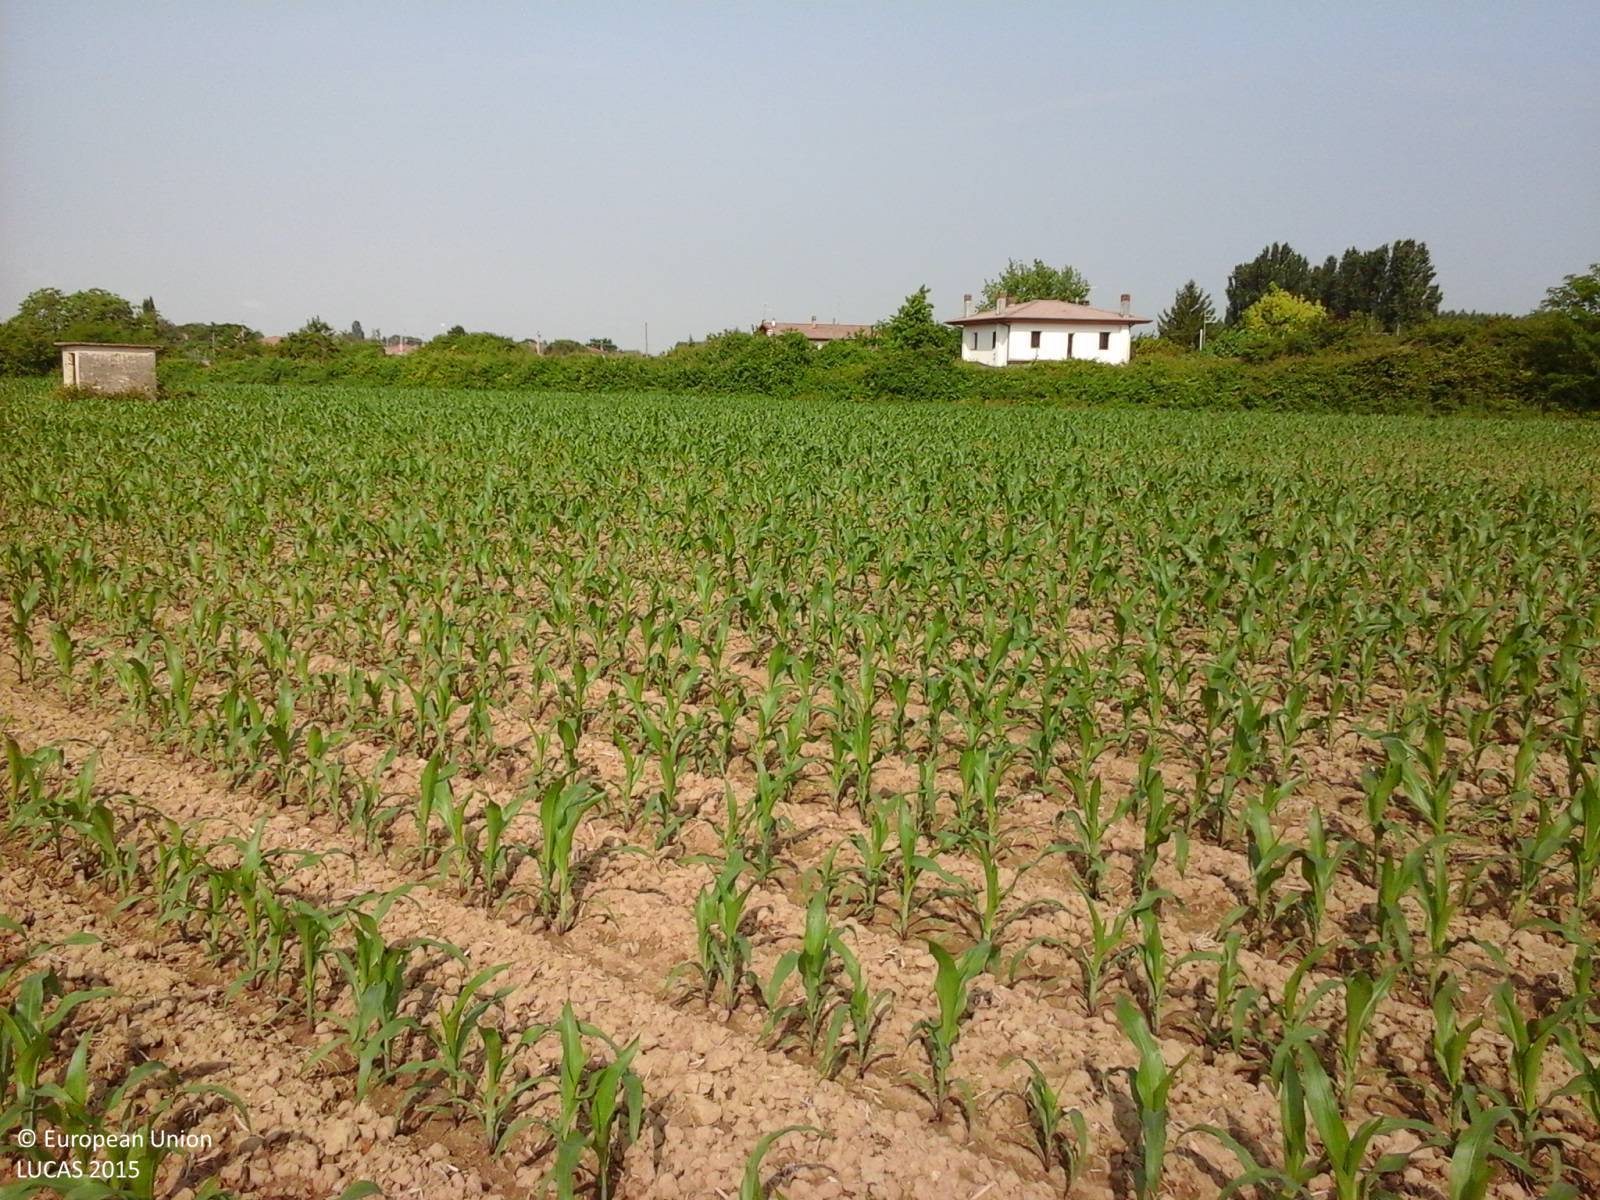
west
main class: Cropland
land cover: Maize
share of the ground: 10 - 25 %
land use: Agriculture (excluding fallow land and kitchen gardens)
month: May
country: IT
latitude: 45.8338
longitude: 13.2274
